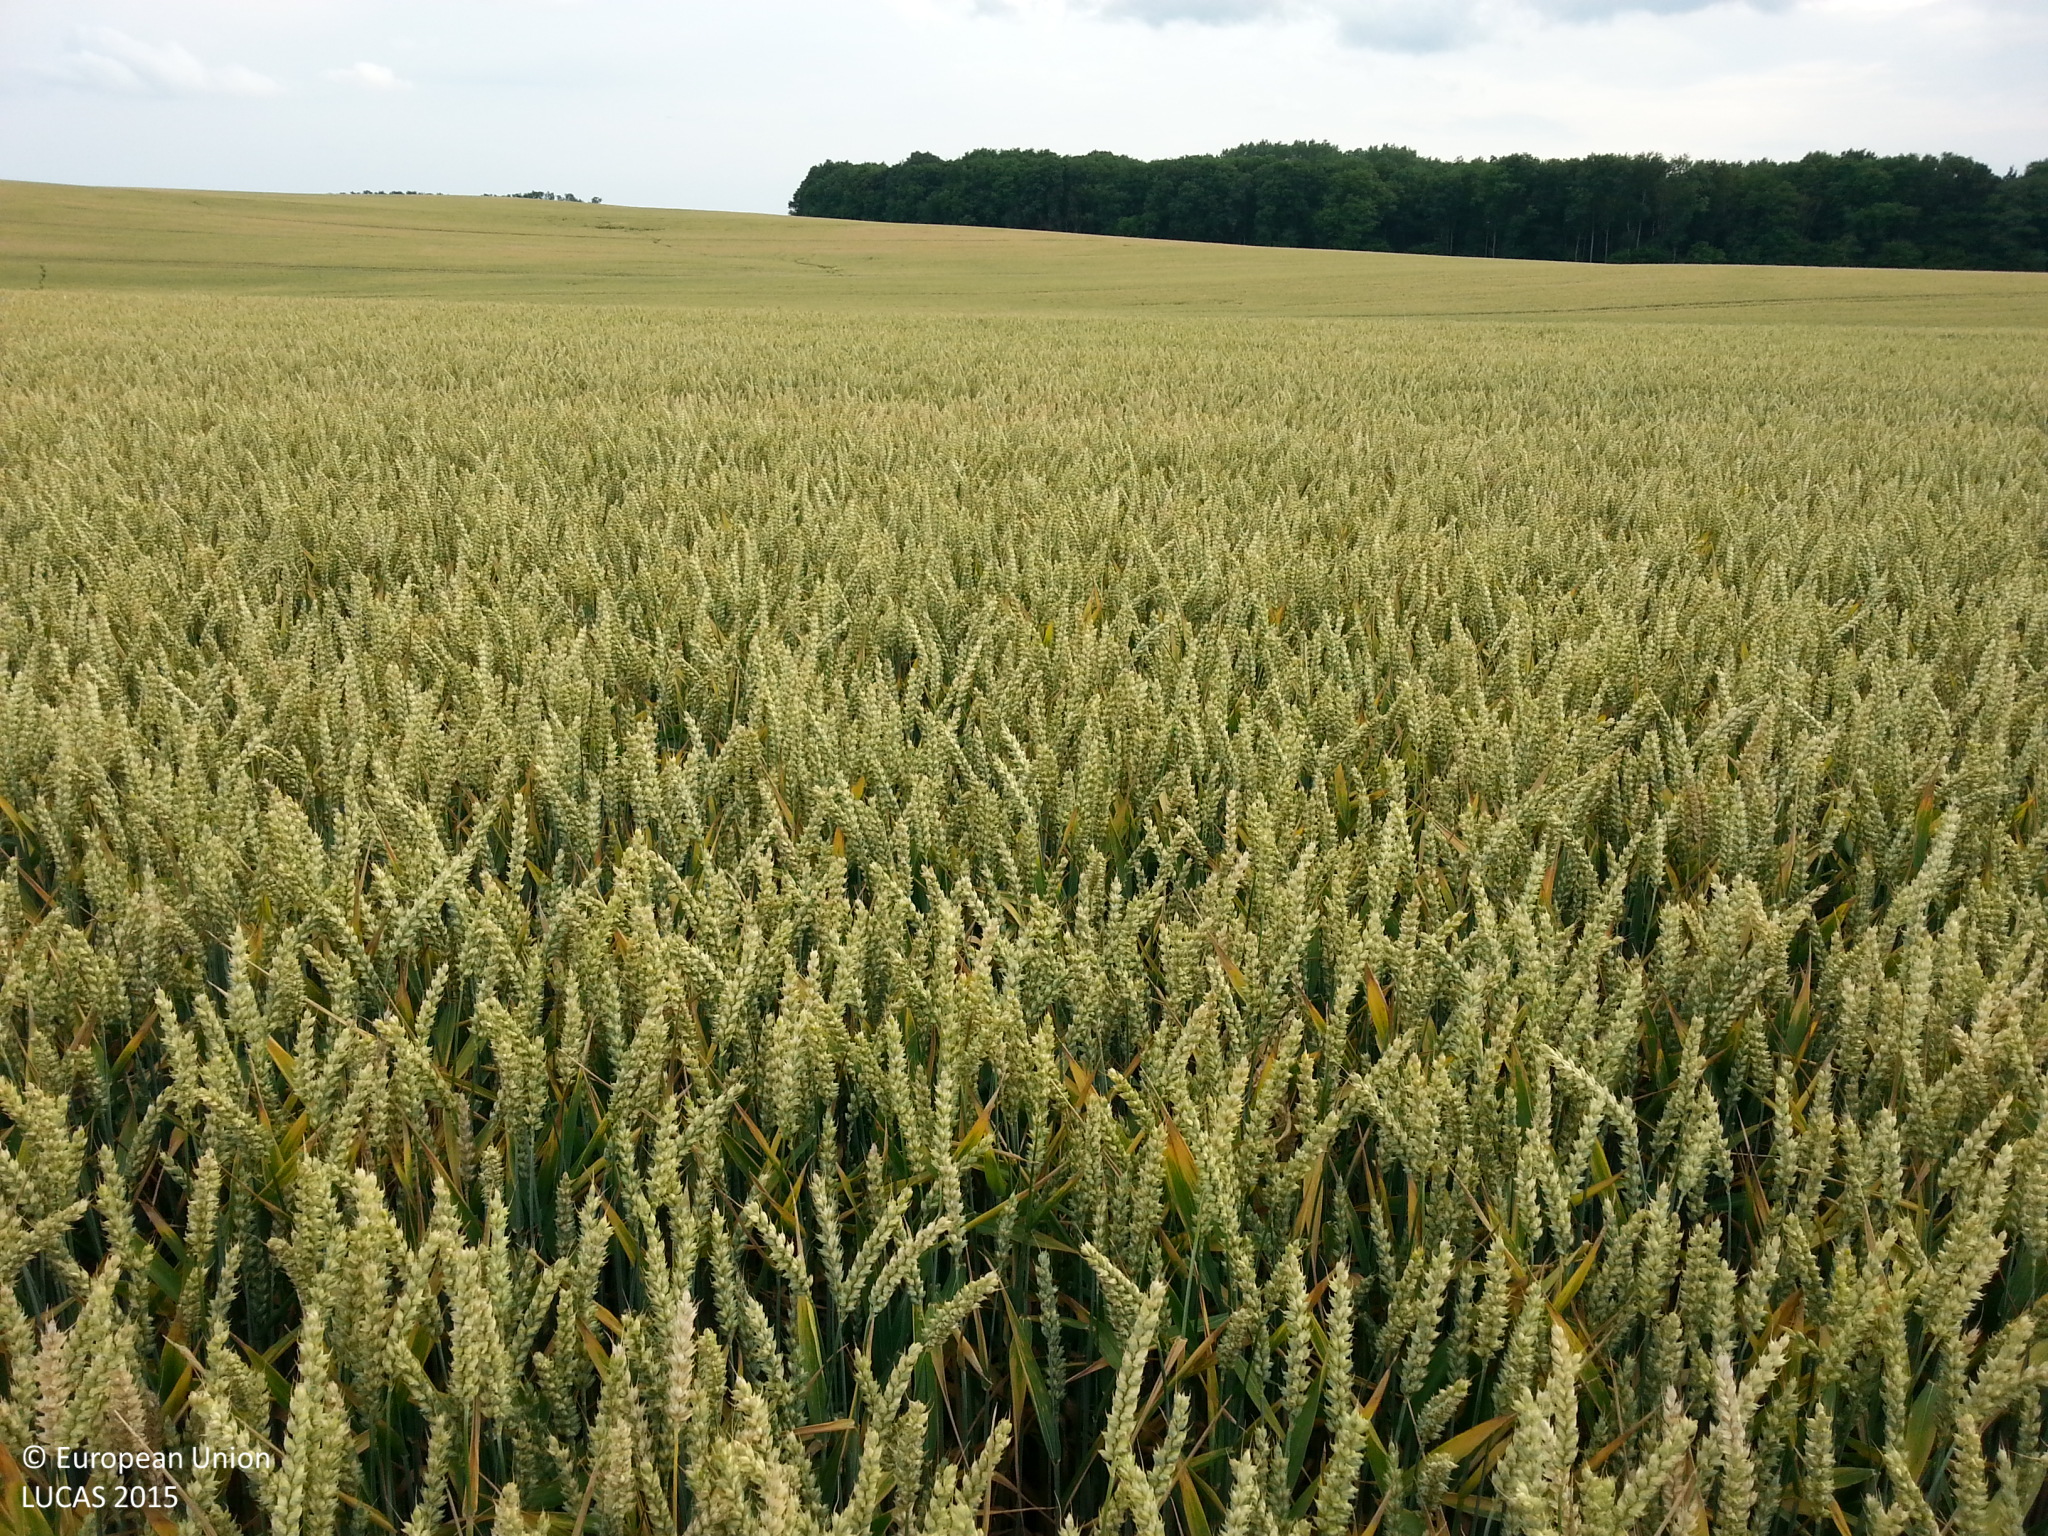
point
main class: Cropland
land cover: Common wheat
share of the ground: > 75 %
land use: Agriculture (excluding fallow land and kitchen gardens)
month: July
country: DE
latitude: 53.9534
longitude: 11.1728
